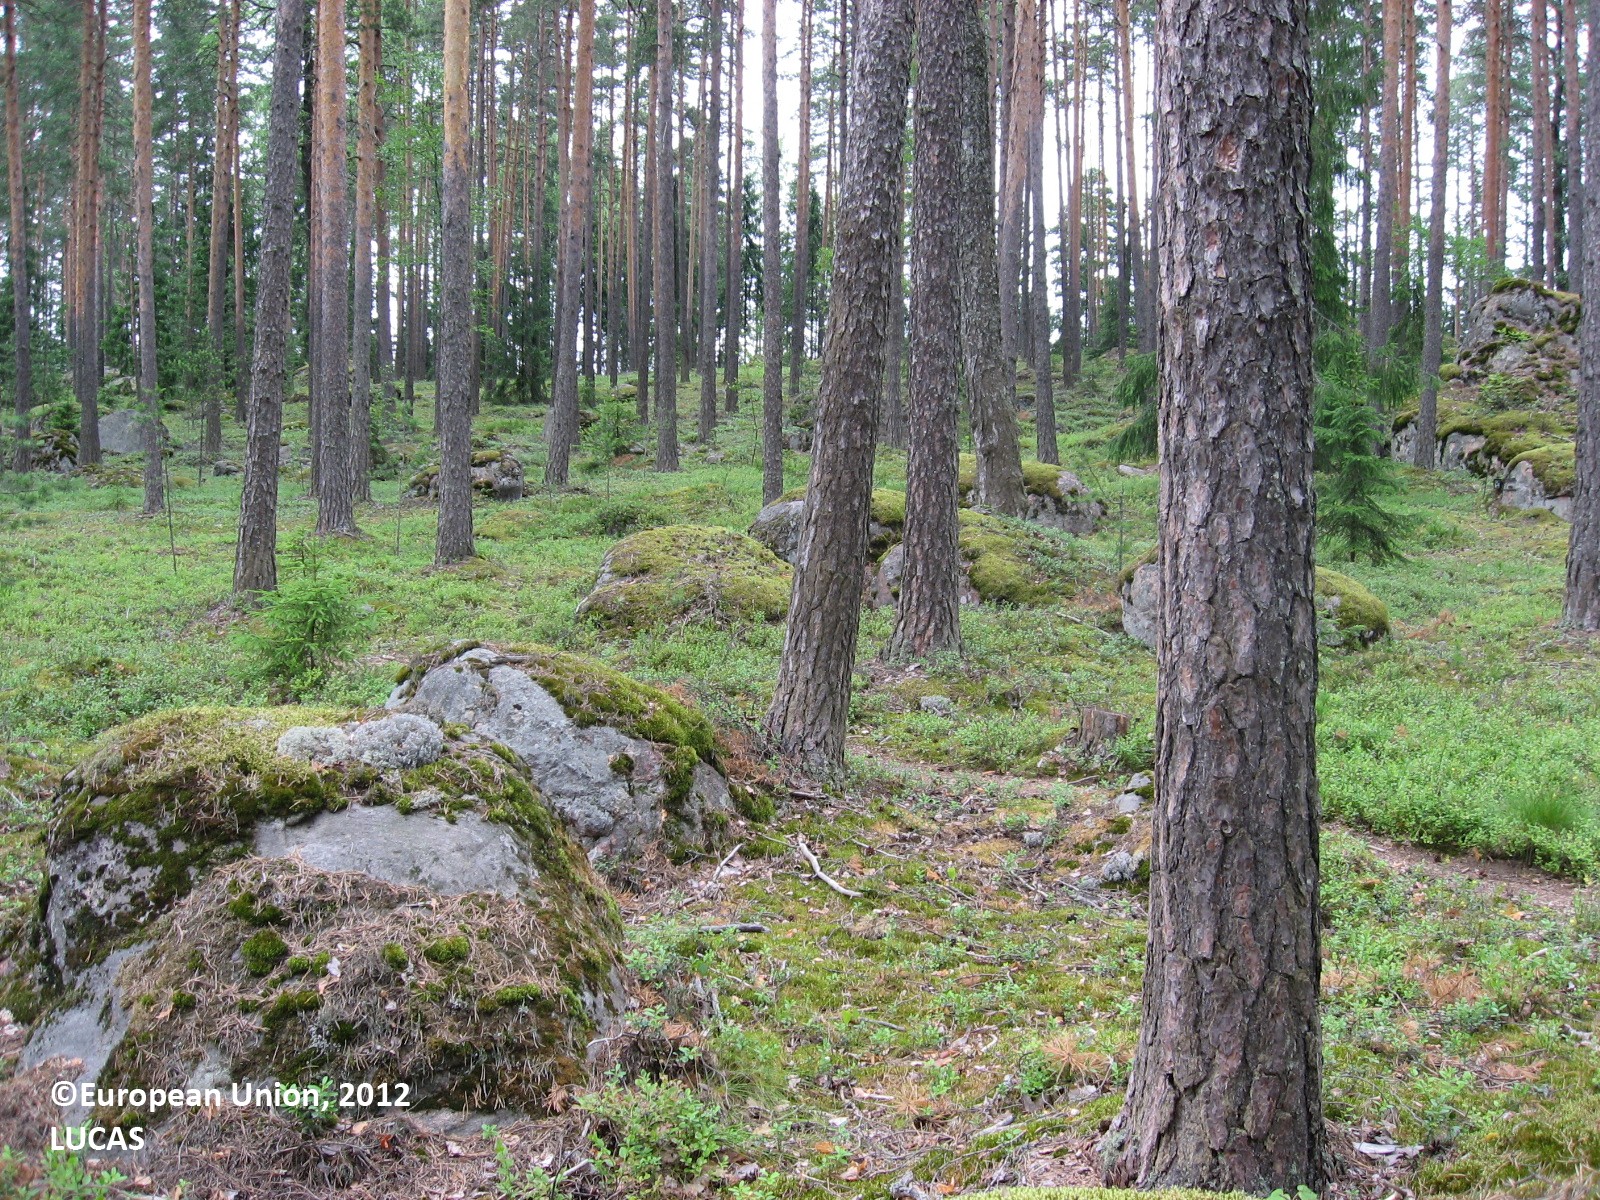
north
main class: Woodland
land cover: Pine dominated coniferous woodland
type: boreal forest
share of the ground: 50 - 75 %
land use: Community services
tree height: > 5 m
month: July
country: FI
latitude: 60.9650
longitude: 25.7392
